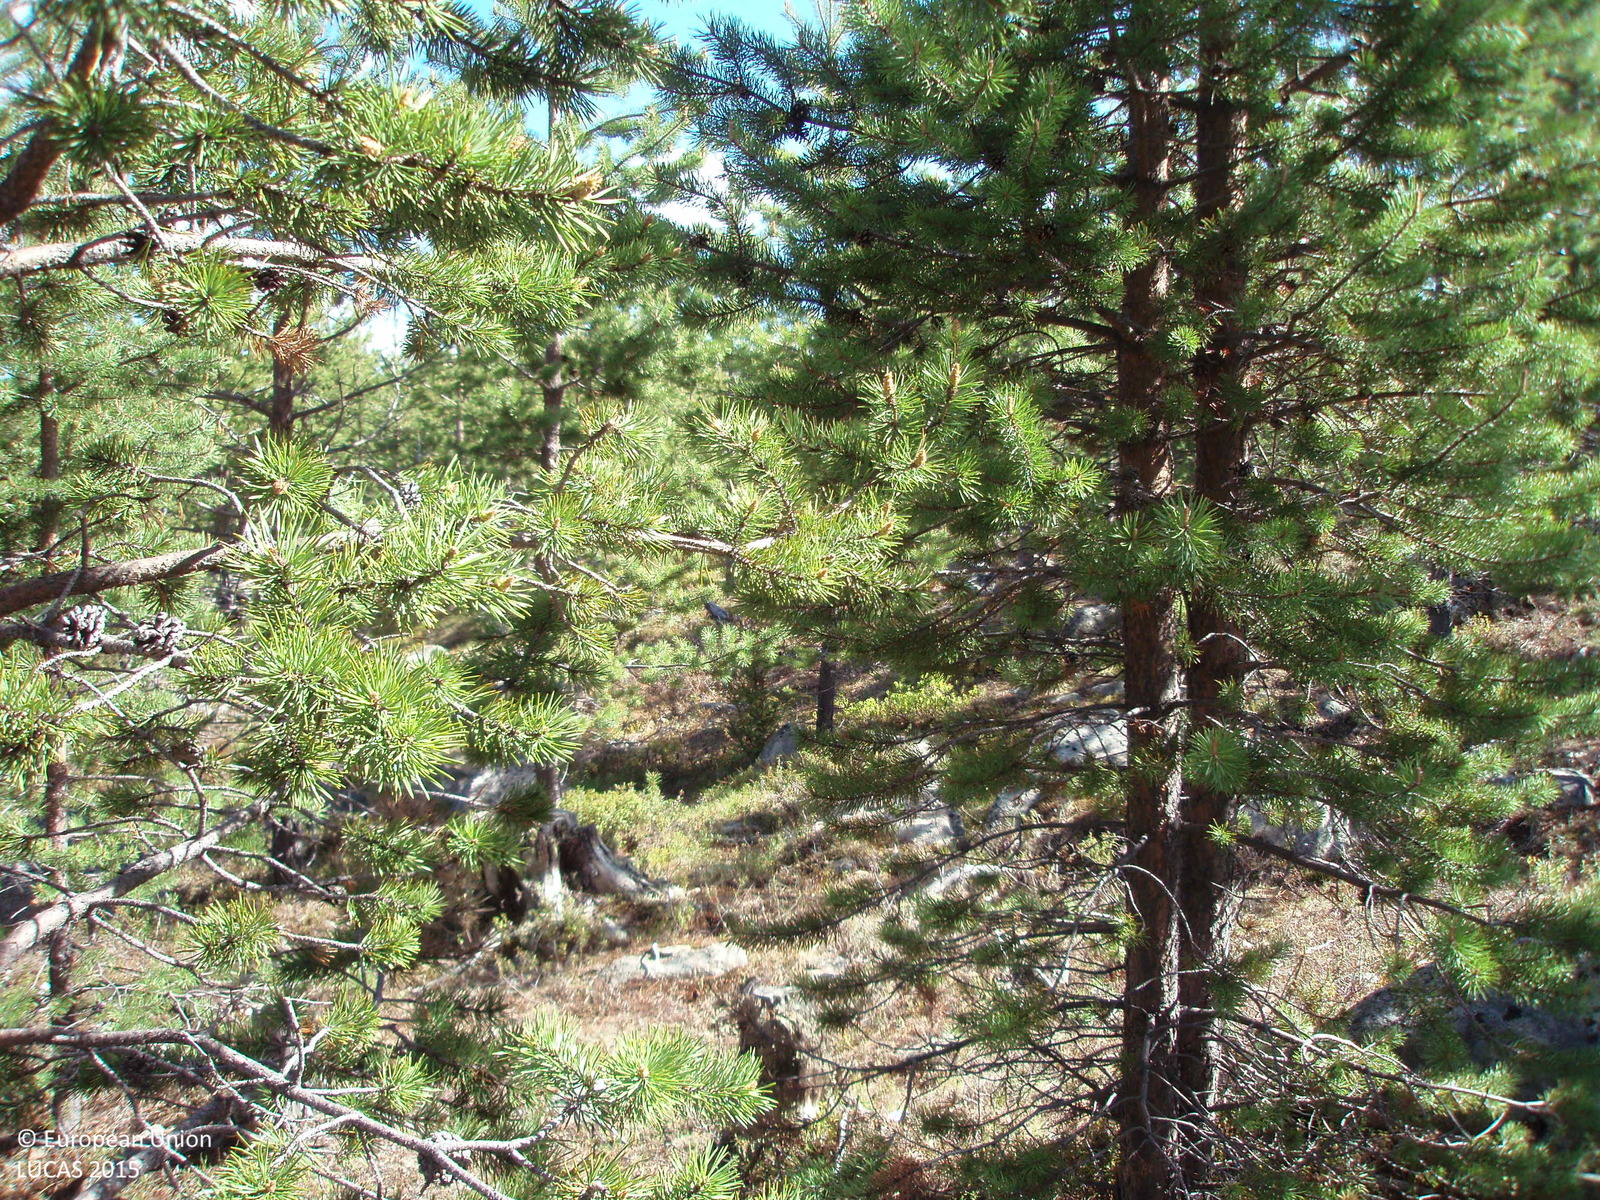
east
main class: Woodland
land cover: Pine dominated coniferous woodland
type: boreal forest
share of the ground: > 75 %
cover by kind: coniferous forest trees 75 %, shrubs 15 %, unconsolidated bare surface 10 %
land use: Forestry
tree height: > 5 m
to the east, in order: Pine dominated coniferous woodland; Shrubland with sparse tree cover; Pine dominated coniferous woodland; Rocks and stones; Pine dominated coniferous woodland; Shrubland with sparse tree cover; Pine dominated coniferous woodland
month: June
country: FI
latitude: 68.6428
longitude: 28.2325
